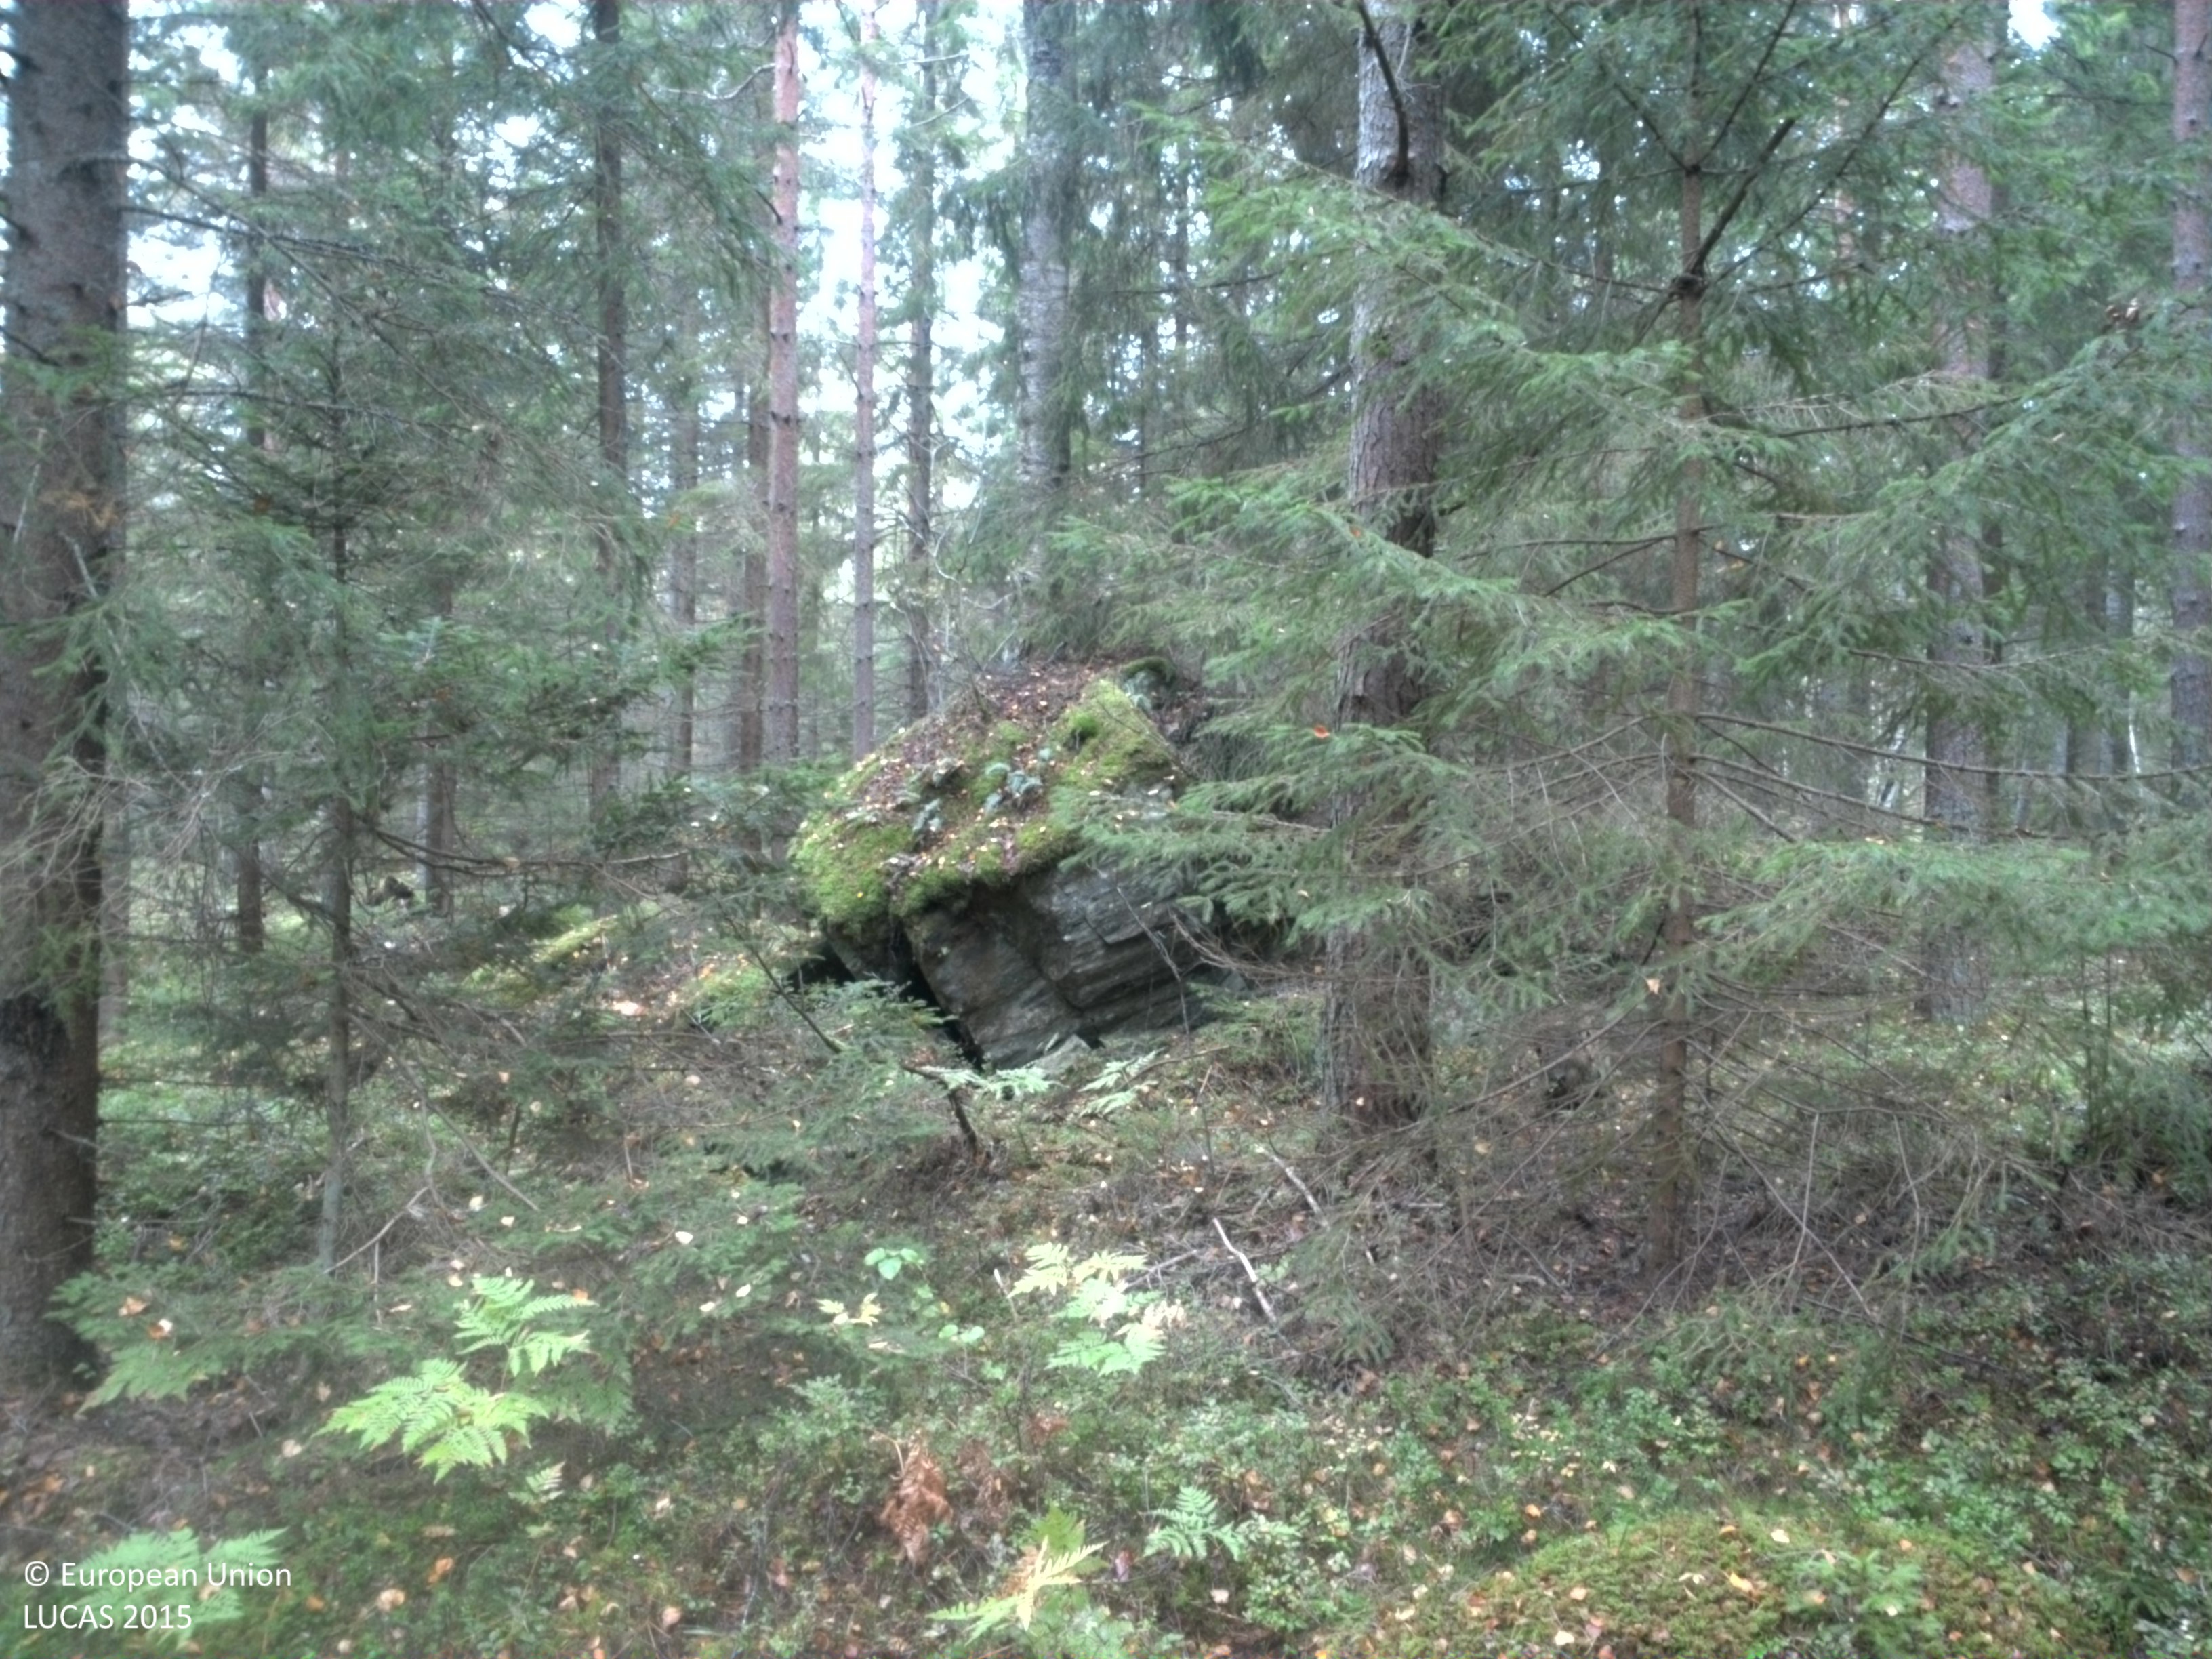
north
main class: Woodland
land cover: Other coniferous woodland
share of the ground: 25 - 50 %
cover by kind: coniferous forest trees 40 %, shrubs 25 %, lichens and mosses 20 %, broadleaved forest trees 10 %, herbaceous plants 5 %
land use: Forestry
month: September
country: SE
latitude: 58.8426
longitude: 14.0650
